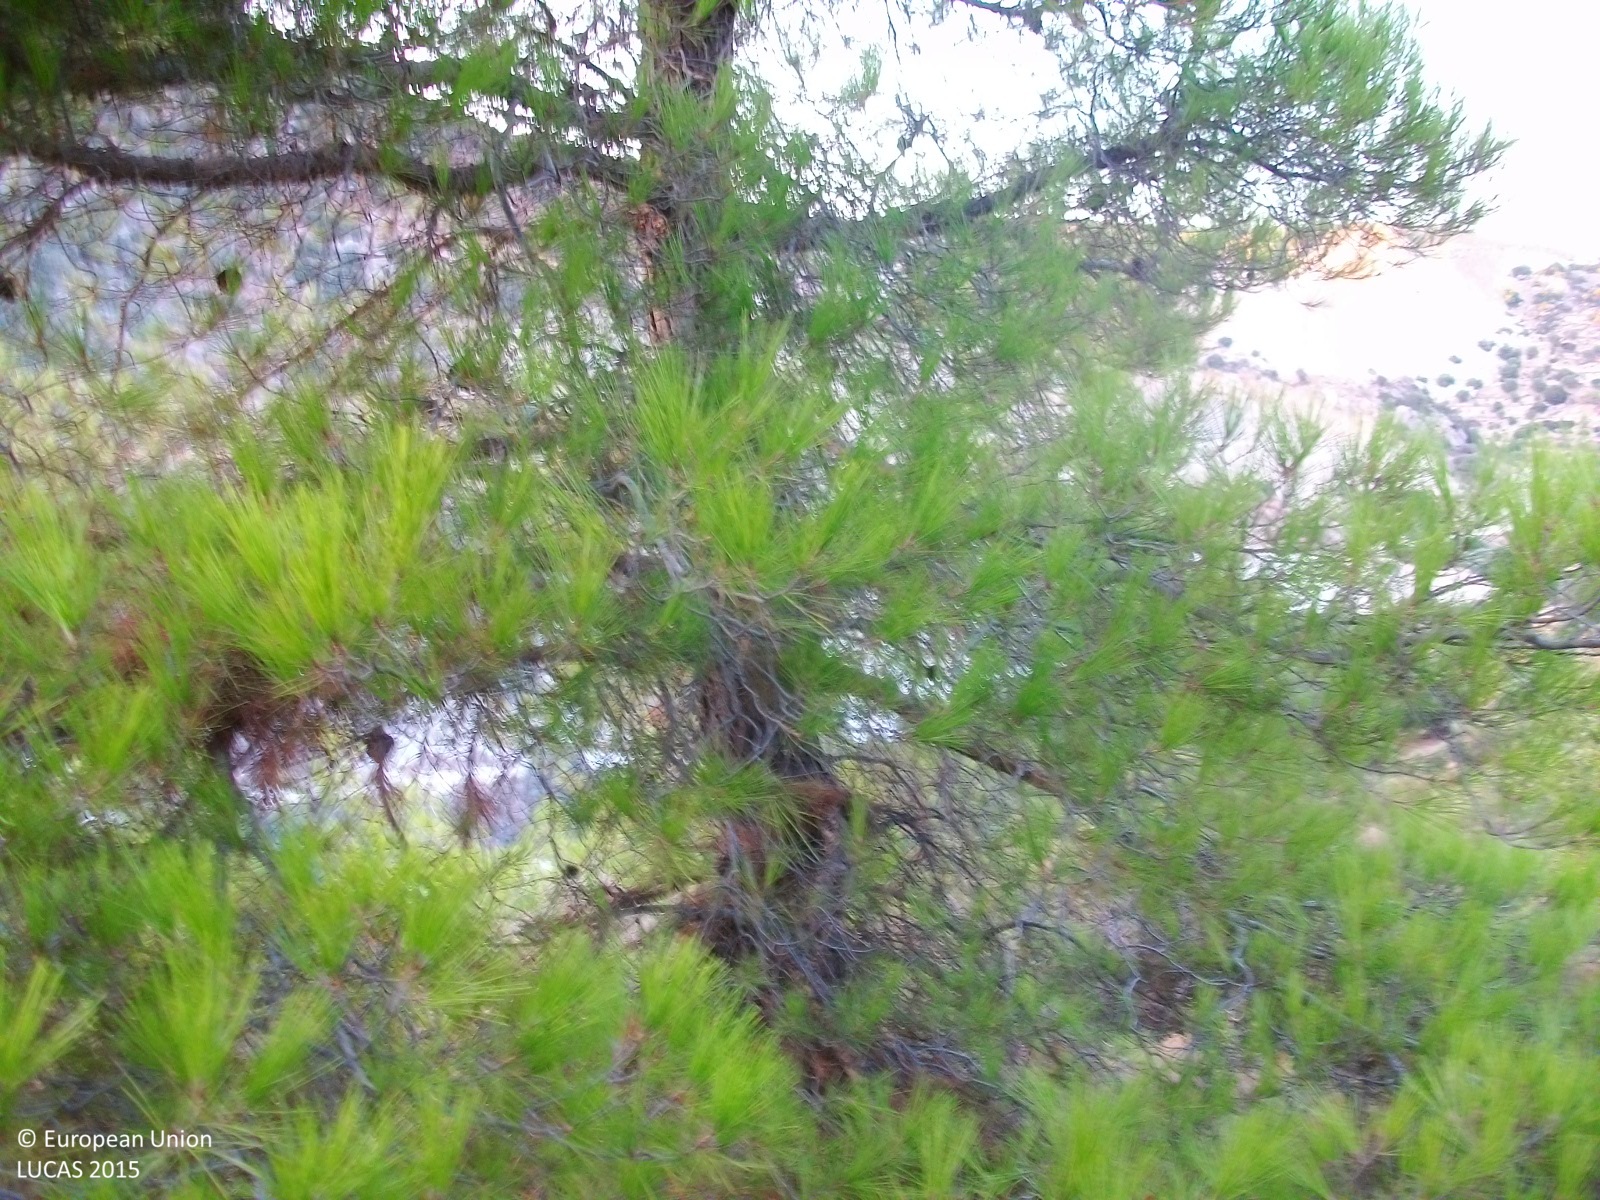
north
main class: Woodland
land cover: Pine dominated coniferous woodland
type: coniferous forest of the mediterranean region
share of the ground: 10 - 25 %
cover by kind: shrubs 70 %, coniferous forest trees 20 %, herbaceous plants 10 %
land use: Semi-natural and natural areas not in use
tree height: < 5 m
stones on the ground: 10 - 25 %
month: August
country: GR
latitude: 35.1139
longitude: 25.7629
